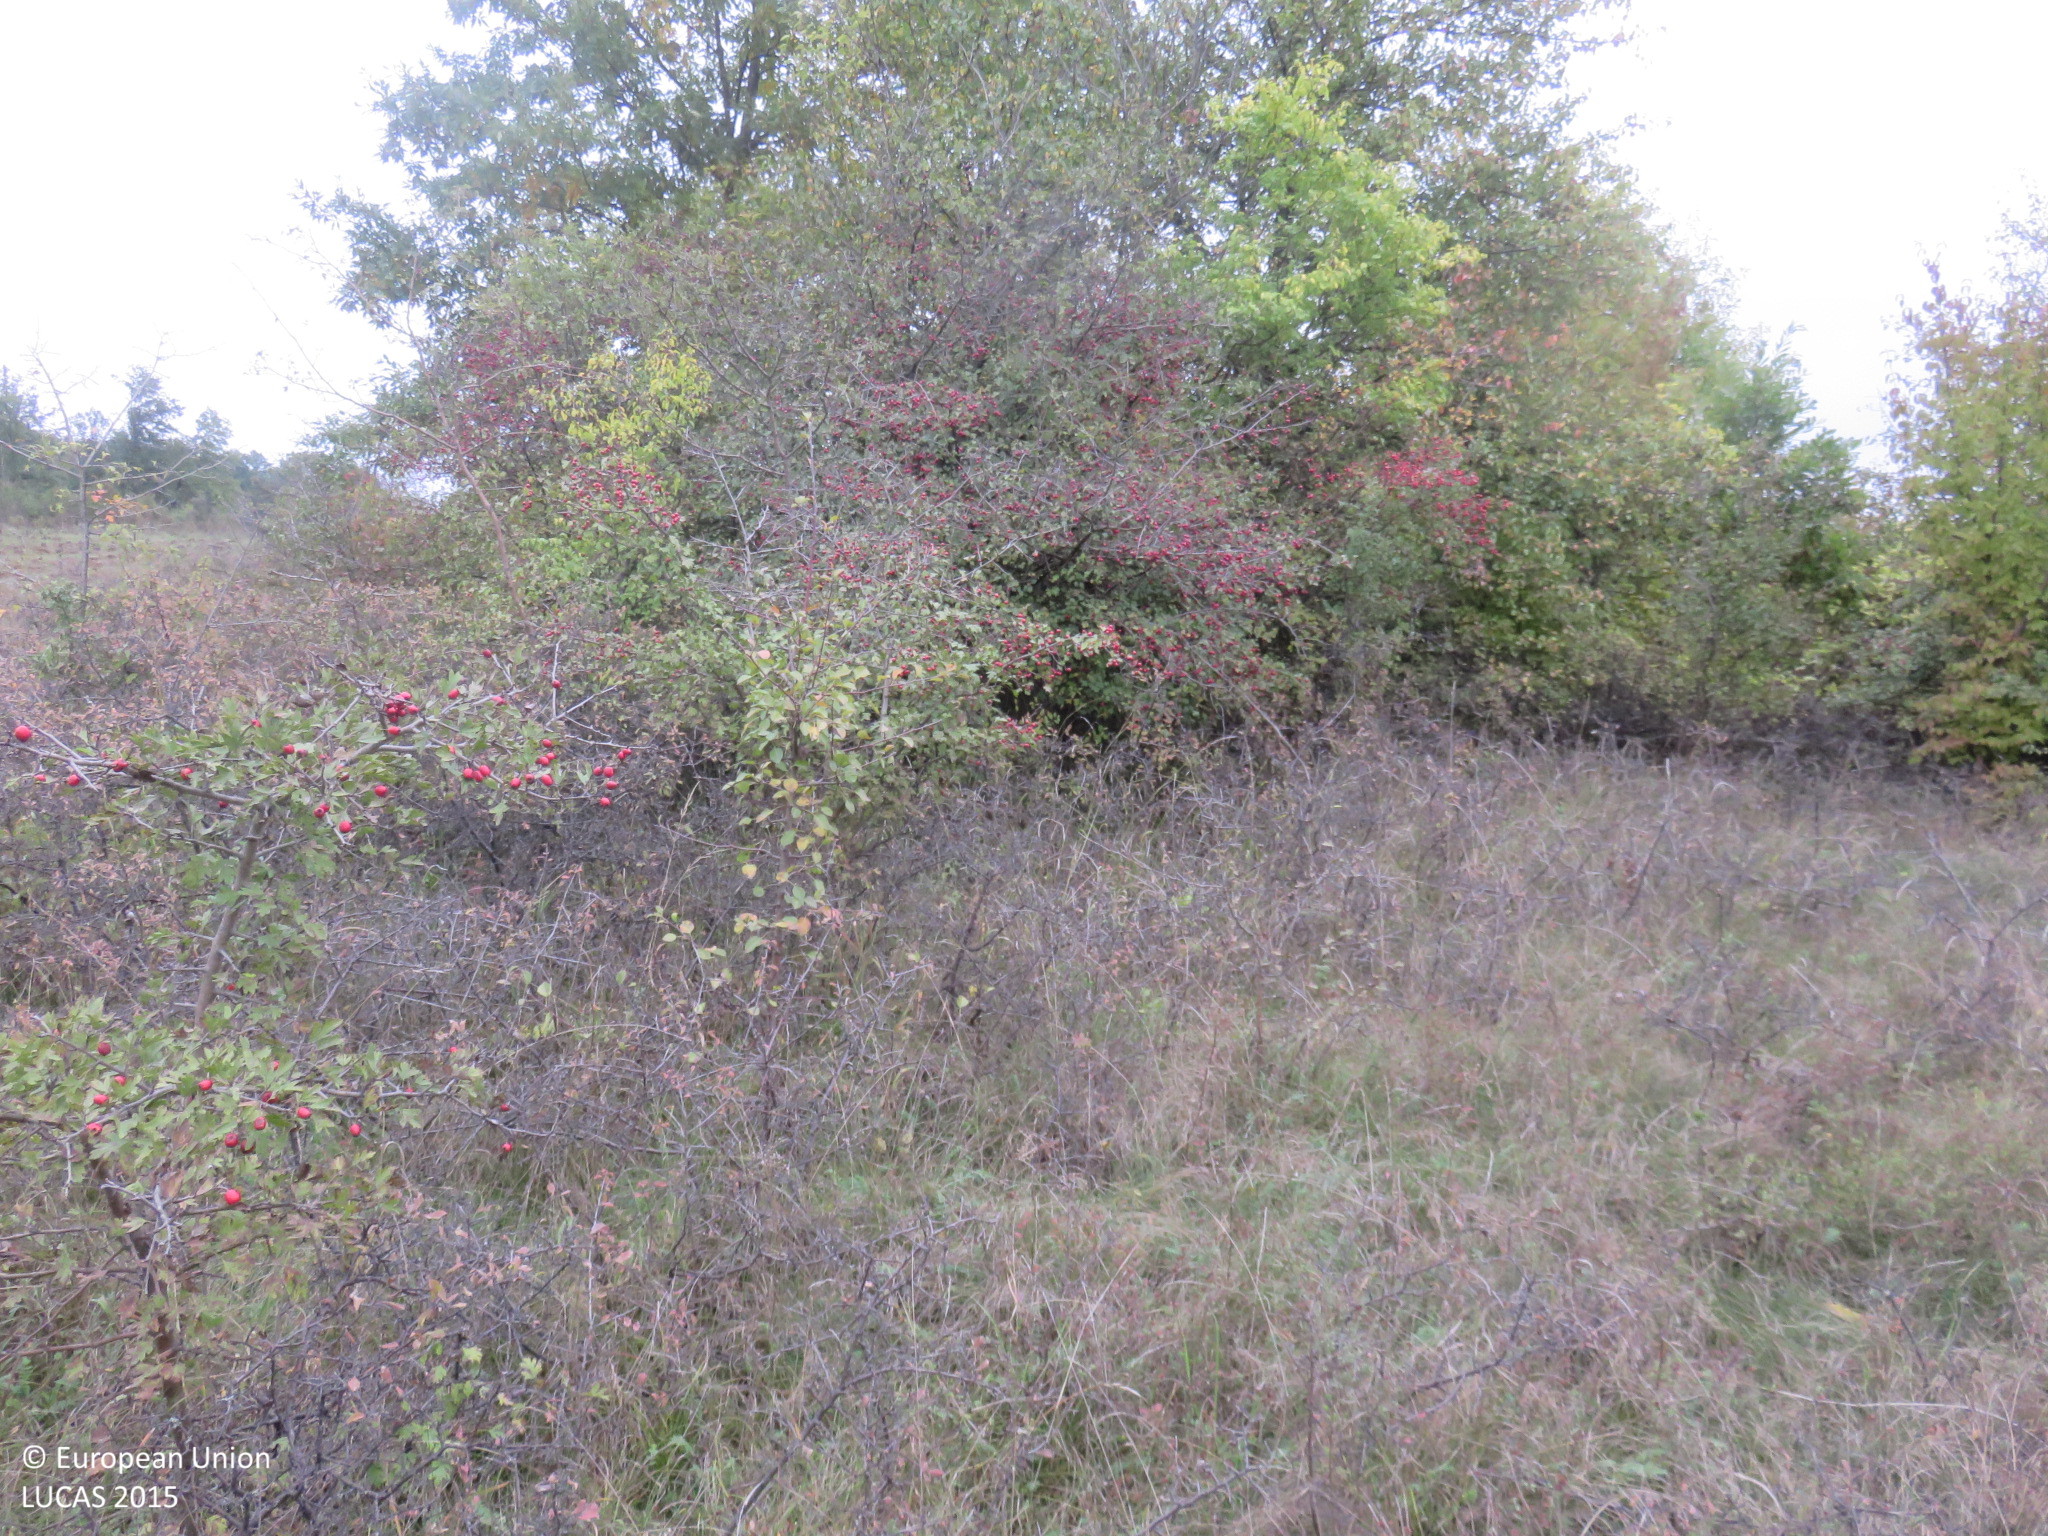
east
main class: Shrubland
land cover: Shrubland with sparse tree cover
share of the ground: > 75 %
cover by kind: shrubs 95 %, broadleaved forest trees 5 %
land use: Semi-natural and natural areas not in use
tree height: < 5 m
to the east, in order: Shrubland with sparse tree cover; Broadleaved woodland; Shrubland with sparse tree cover
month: October
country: BG
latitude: 43.0140
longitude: 25.2483
